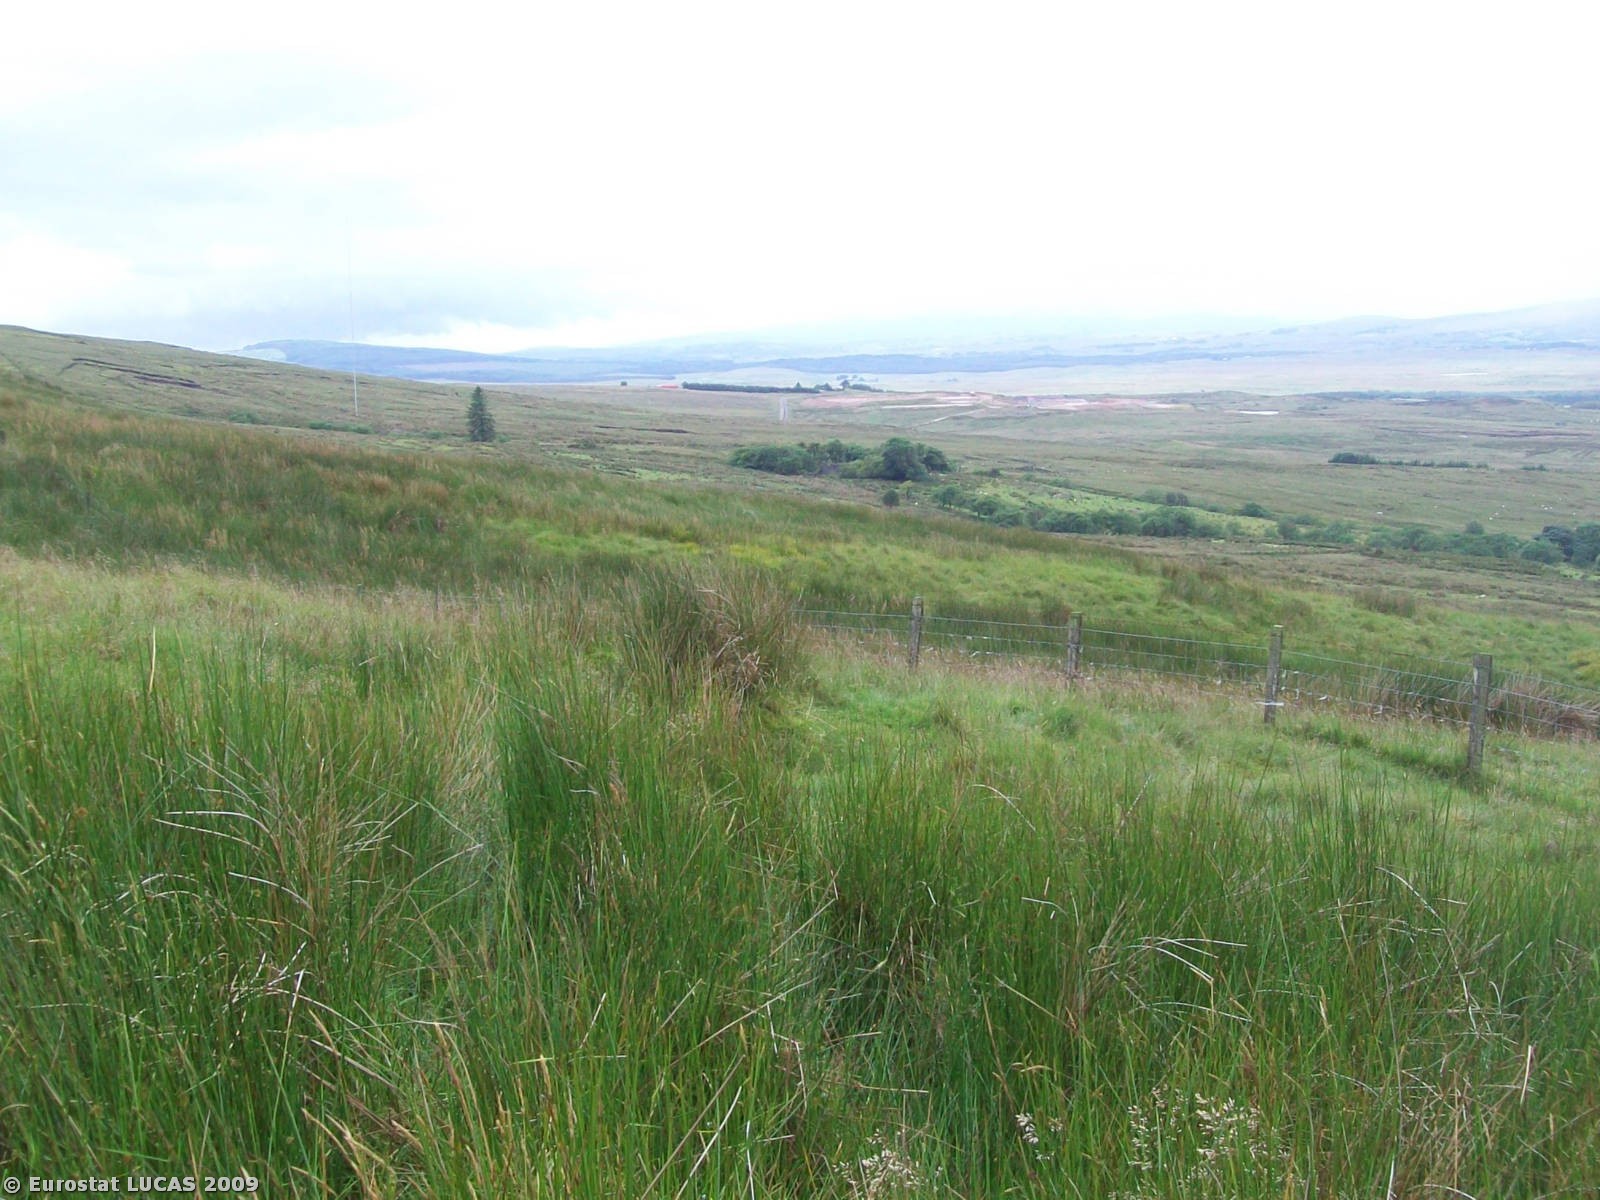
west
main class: Wetlands
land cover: Peatbogs
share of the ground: > 75 %
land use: Unused
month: July
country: GB
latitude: 54.7409
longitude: -6.7674
